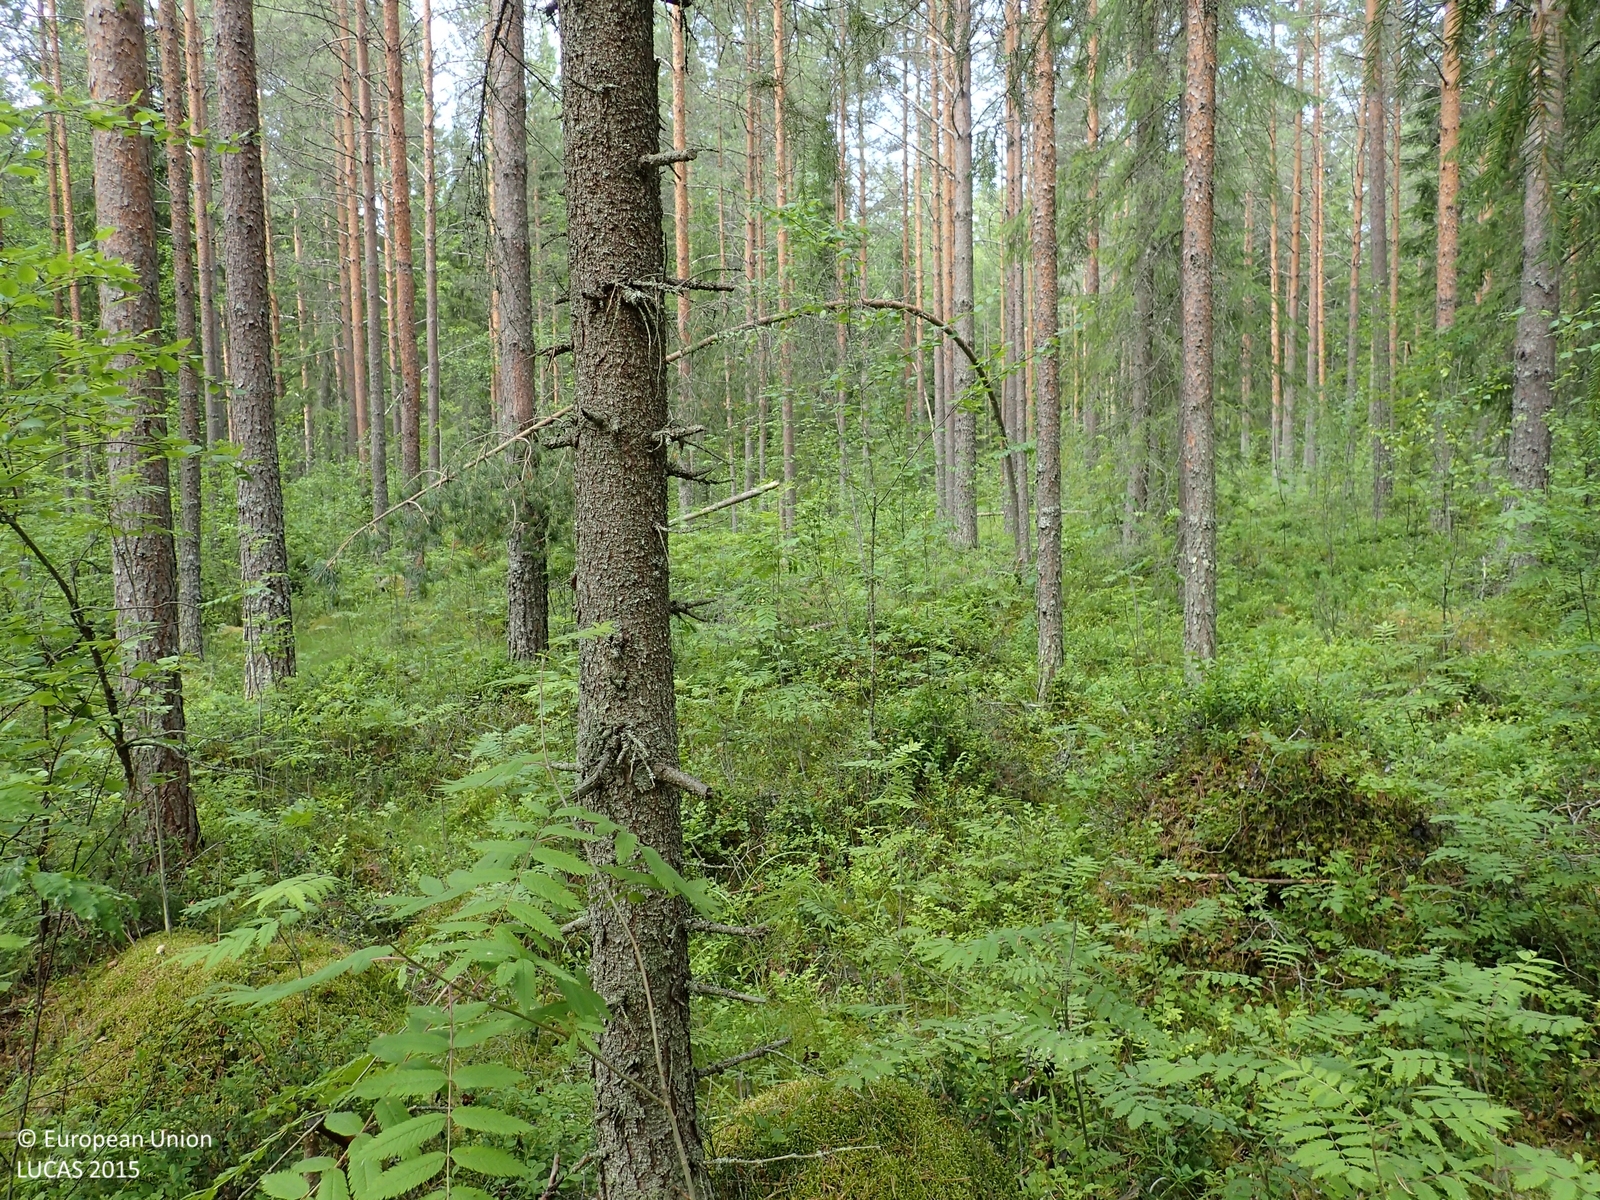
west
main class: Woodland
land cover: Pine dominated coniferous woodland
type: boreal forest
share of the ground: 50 - 75 %
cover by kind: coniferous forest trees 55 %, shrubs 30 %, broadleaved forest trees 10 %, herbaceous plants 5 %
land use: Forestry
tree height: > 5 m
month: July
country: FI
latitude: 62.7654
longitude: 23.5651
